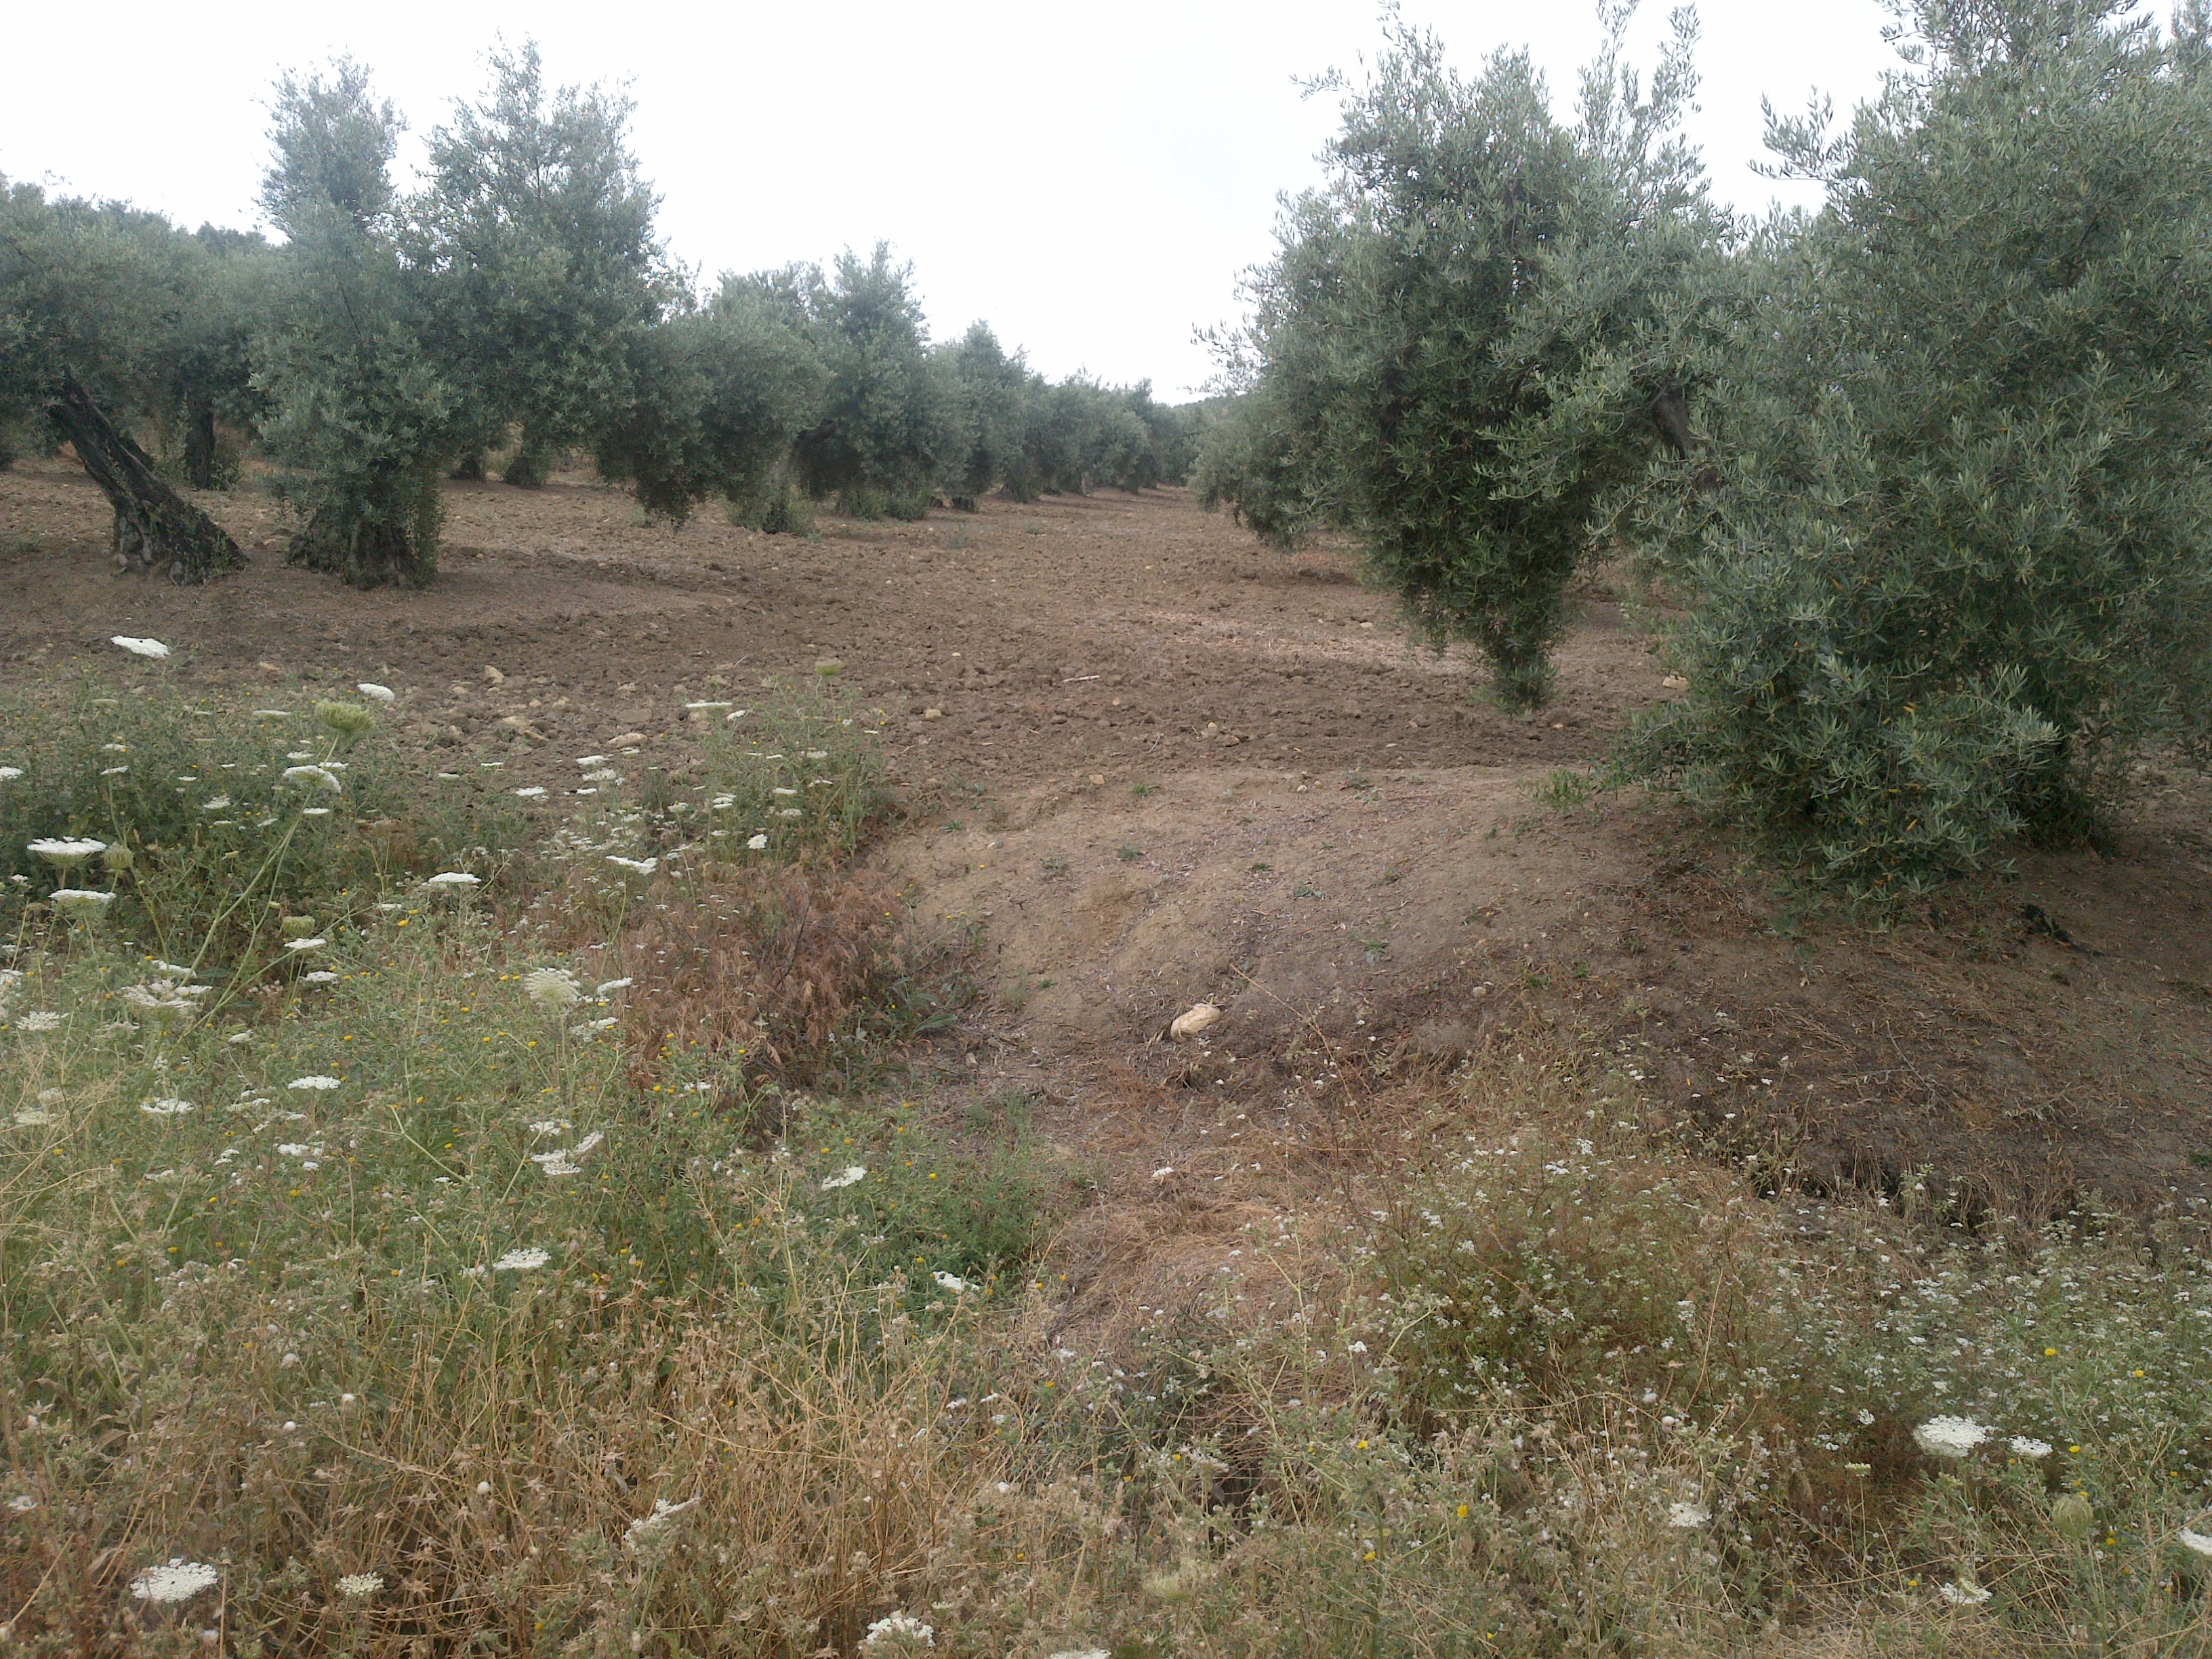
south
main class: Cropland
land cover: Olive groves
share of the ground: 25 - 50 %
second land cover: Other bare soil
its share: > 75 %
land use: Agriculture (excluding fallow land and kitchen gardens)
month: June
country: ES
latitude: 37.9240
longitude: -4.3319
